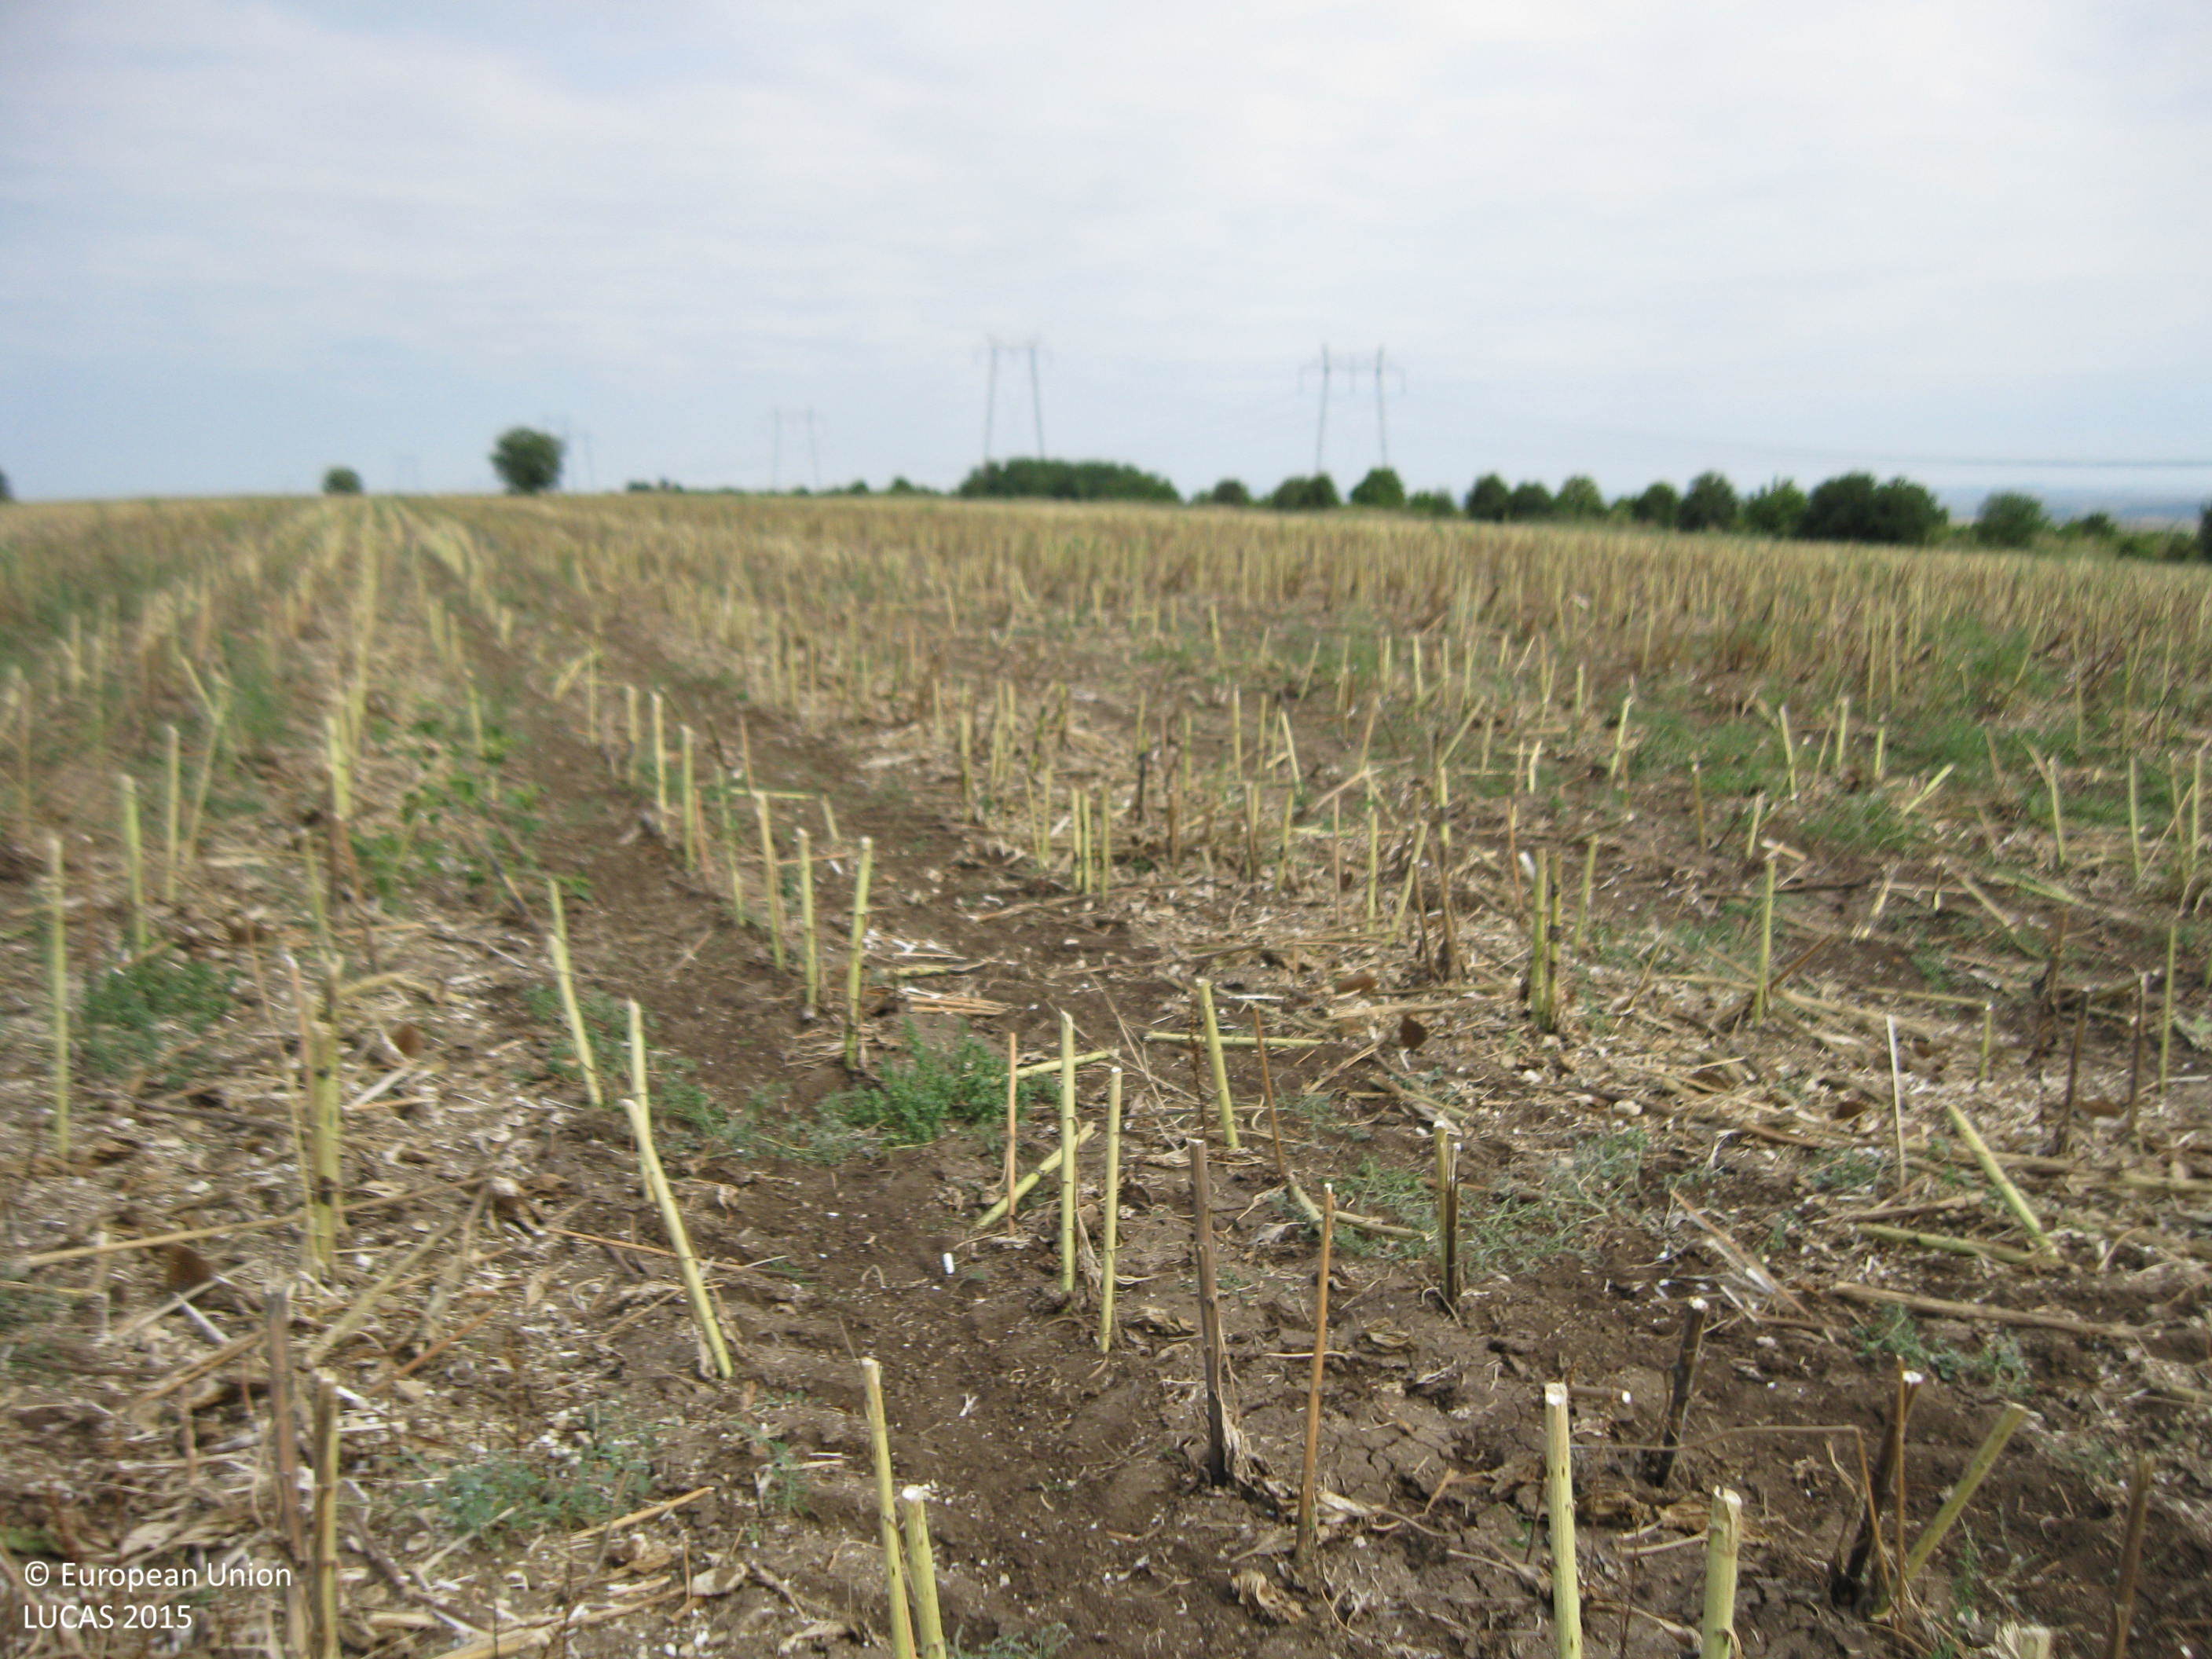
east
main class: Cropland
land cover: Sunflower
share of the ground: < 10 %
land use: Agriculture (excluding fallow land and kitchen gardens)
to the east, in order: Sunflower
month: September
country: BG
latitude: 42.0996
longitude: 25.1117
